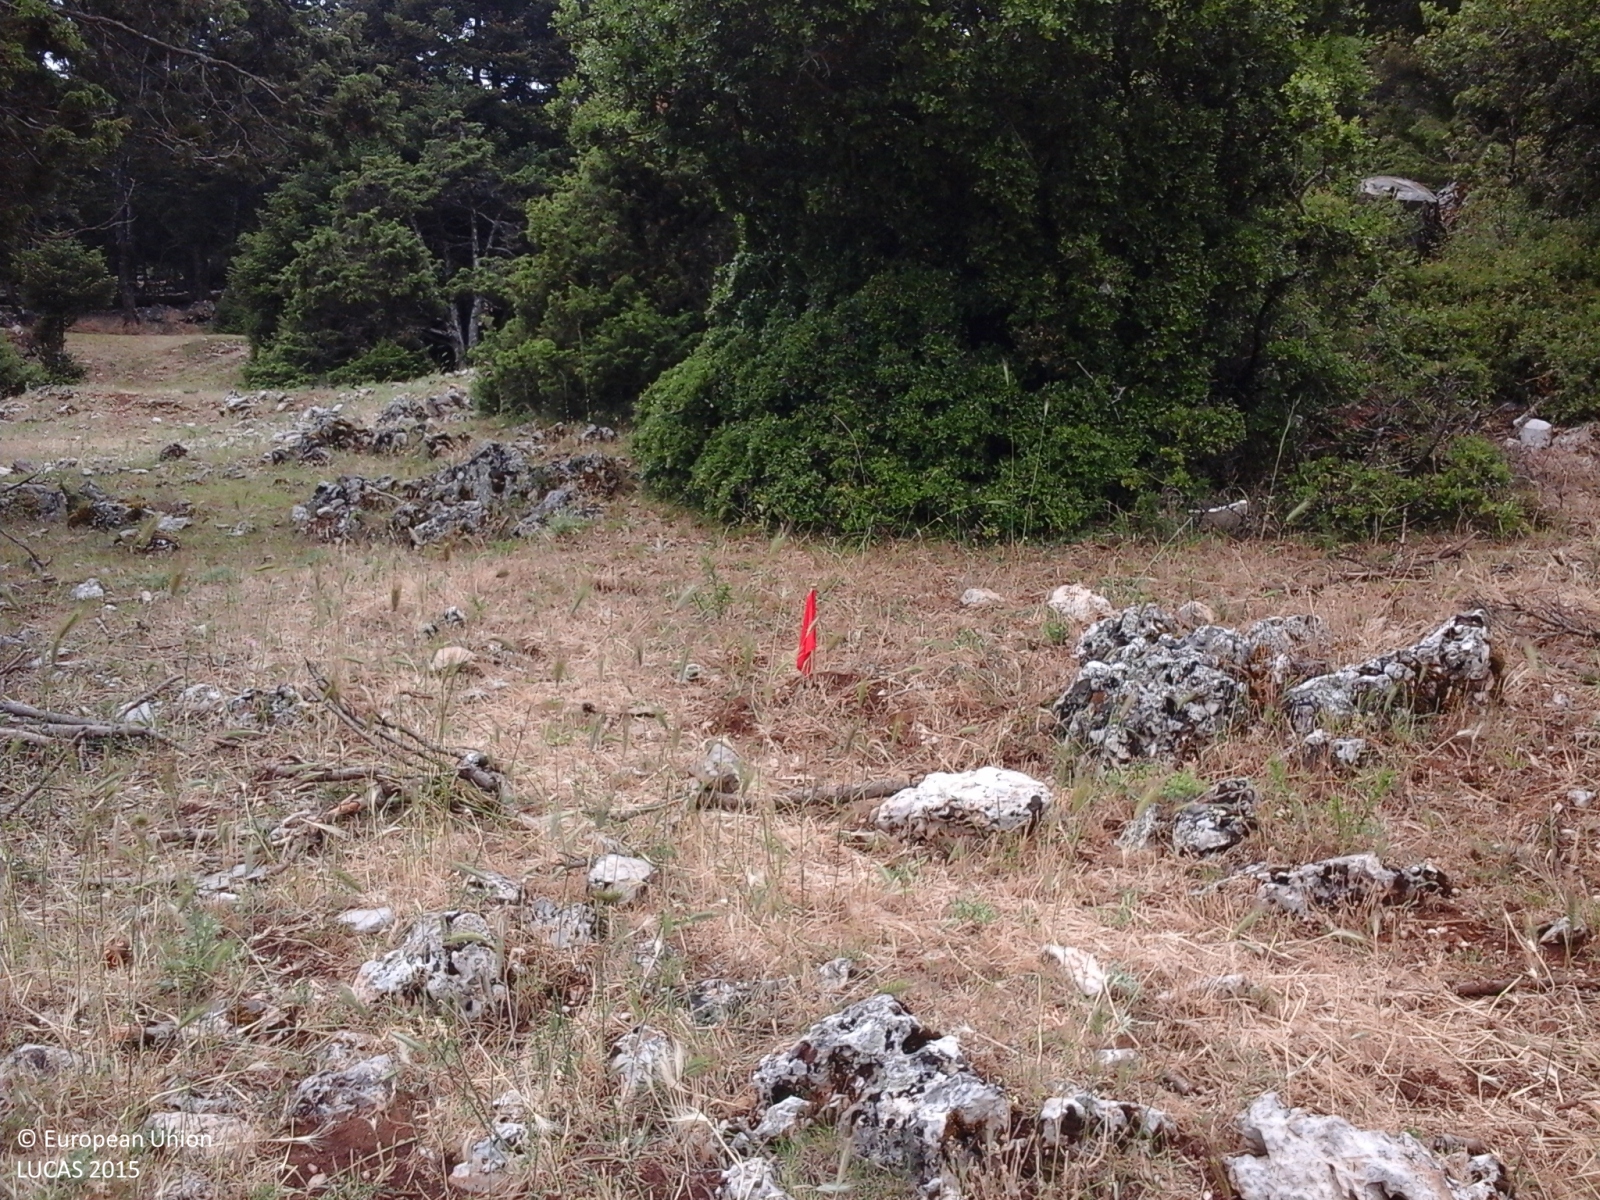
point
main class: Grassland
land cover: Grassland with sparse tree/shrub cover
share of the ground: > 75 %
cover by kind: herbaceous plants 85 %, coniferous forest trees 5 %, shrubs 5 %, unconsolidated bare surface 5 %
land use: Agriculture (excluding fallow land and kitchen gardens)
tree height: < 5 m
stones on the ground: < 10 %
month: June
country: GR
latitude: 38.4844
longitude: 22.2980
